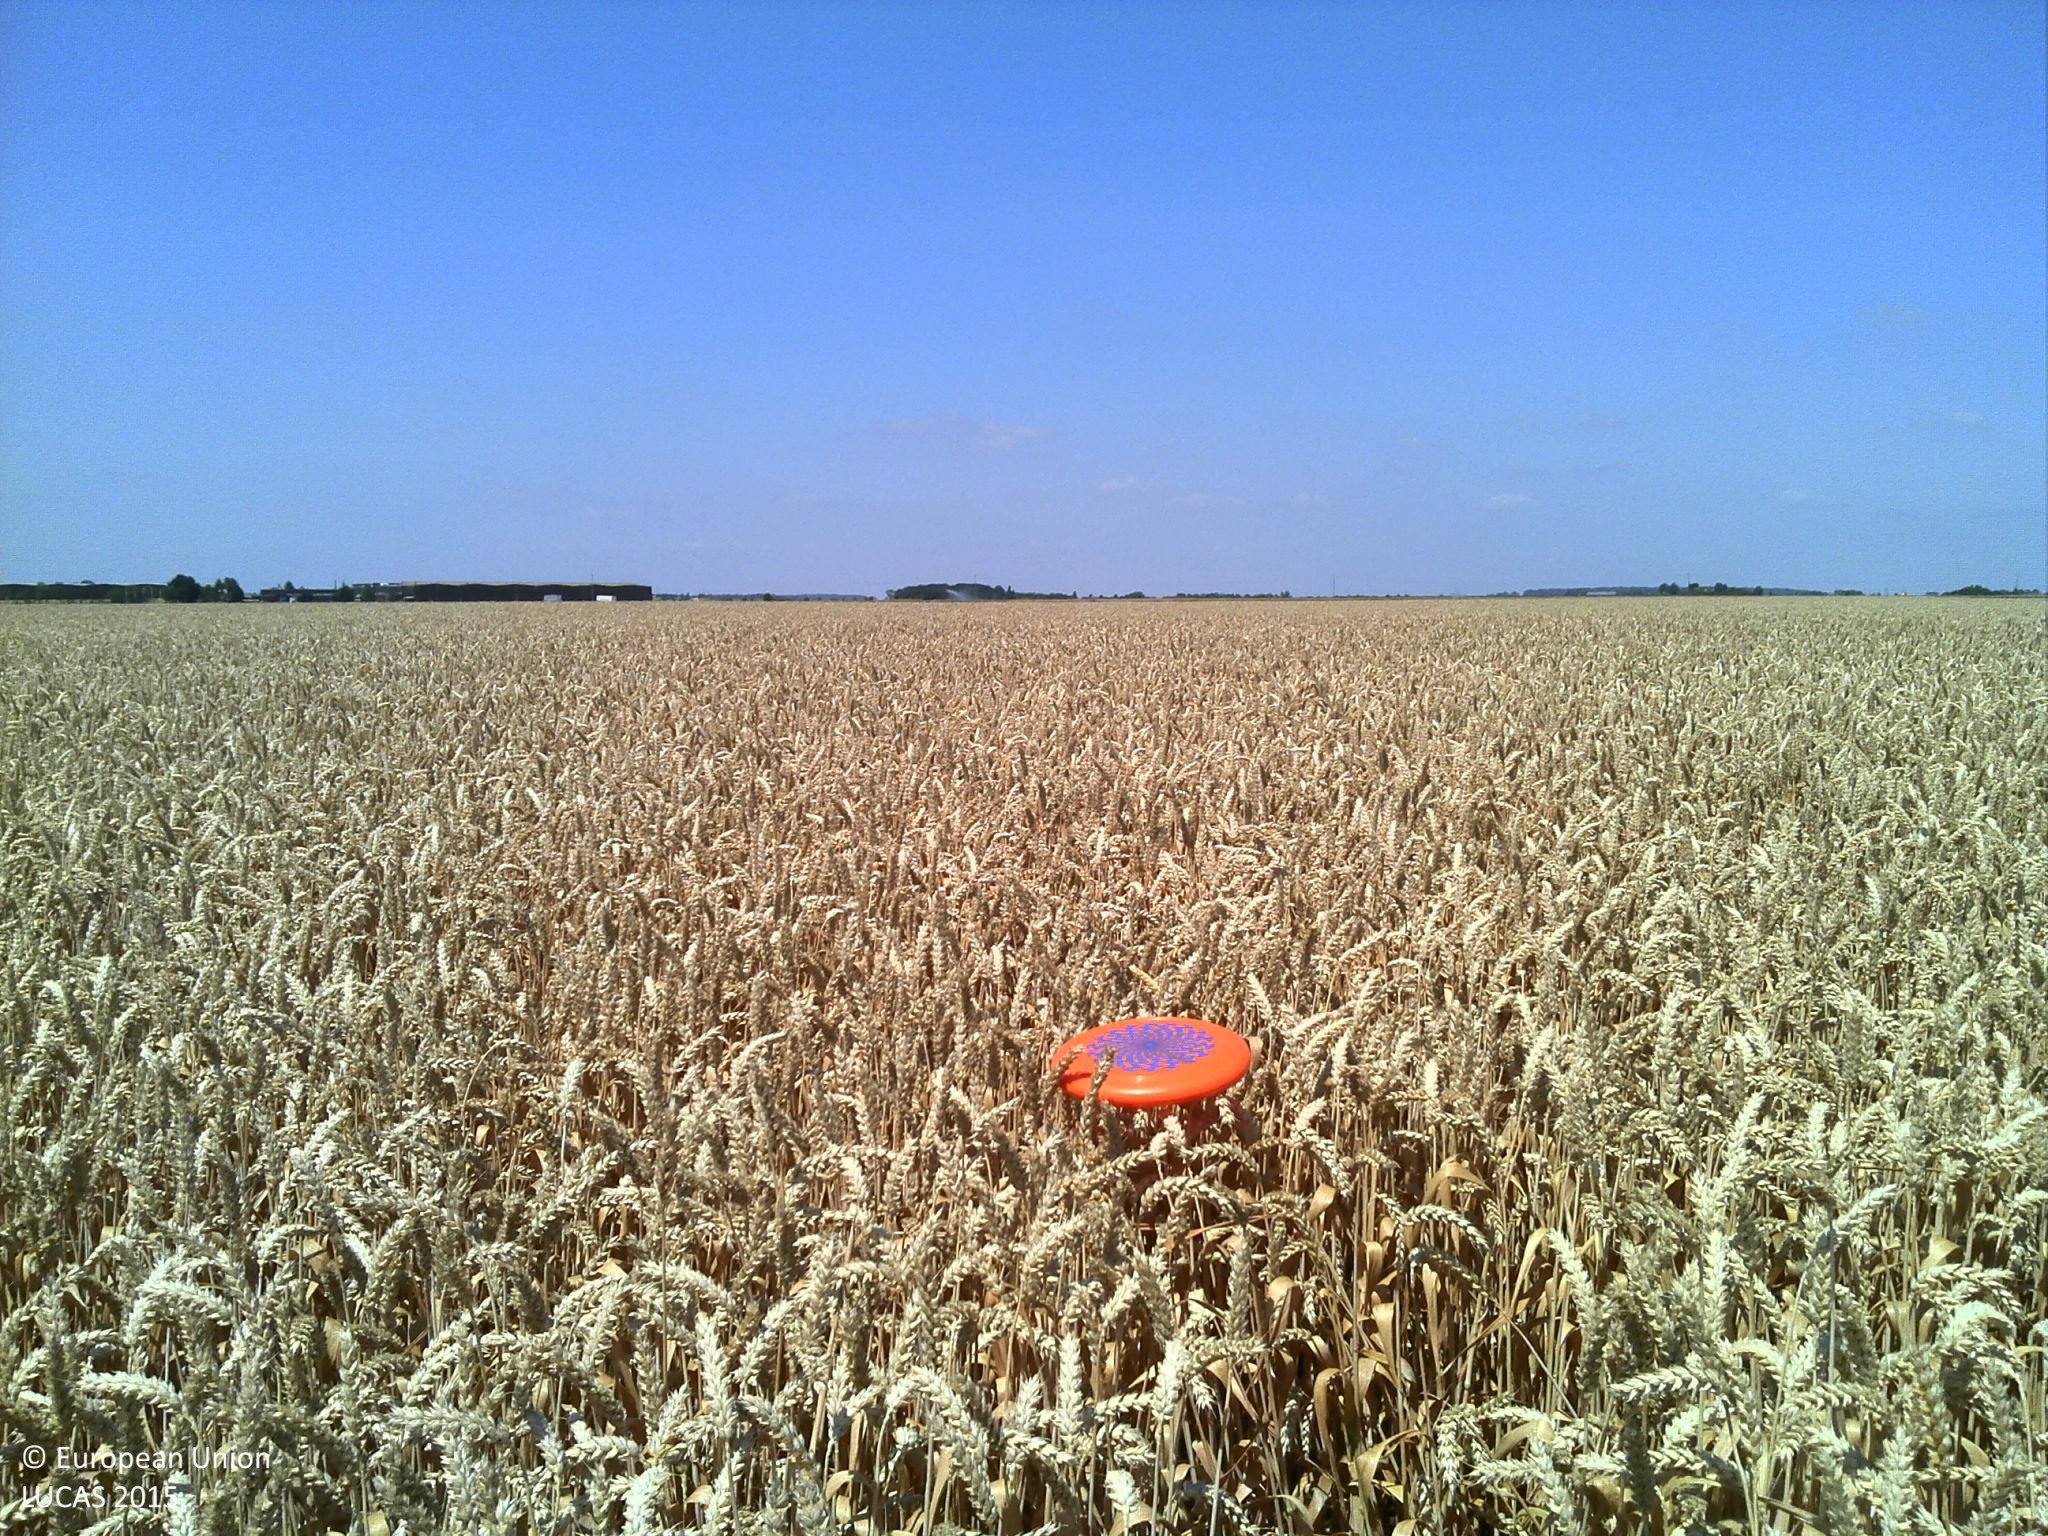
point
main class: Cropland
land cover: Common wheat
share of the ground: > 75 %
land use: Agriculture (excluding fallow land and kitchen gardens)
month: July
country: FR
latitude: 48.4526
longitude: 1.9412
